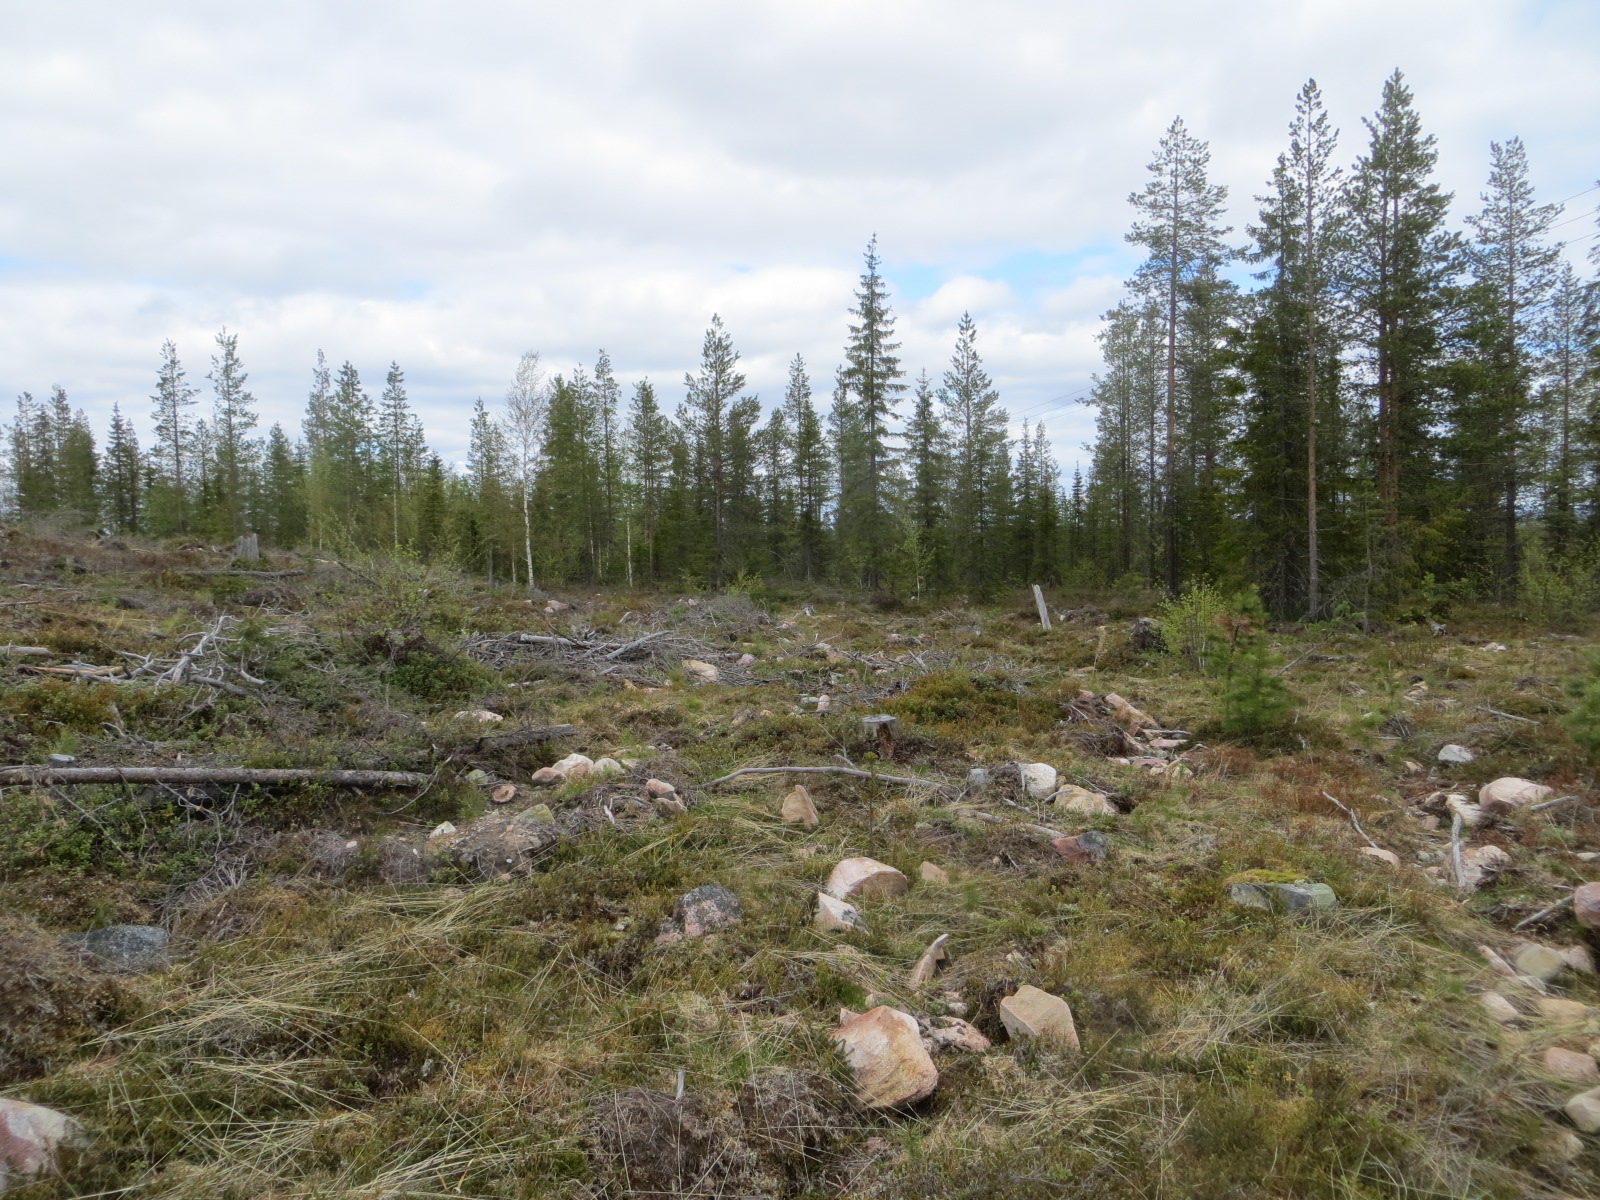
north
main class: Shrubland
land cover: Shrubland with sparse tree cover
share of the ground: > 75 %
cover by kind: shrubs 70 %, herbaceous plants 10 %, unconsolidated bare surface 10 %, coniferous forest trees 5 %, lichens and mosses 5 %
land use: Forestry
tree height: < 5 m
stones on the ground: 25 - 50 %
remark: Clear cut
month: June
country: FI
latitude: 67.6072
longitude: 24.9262
